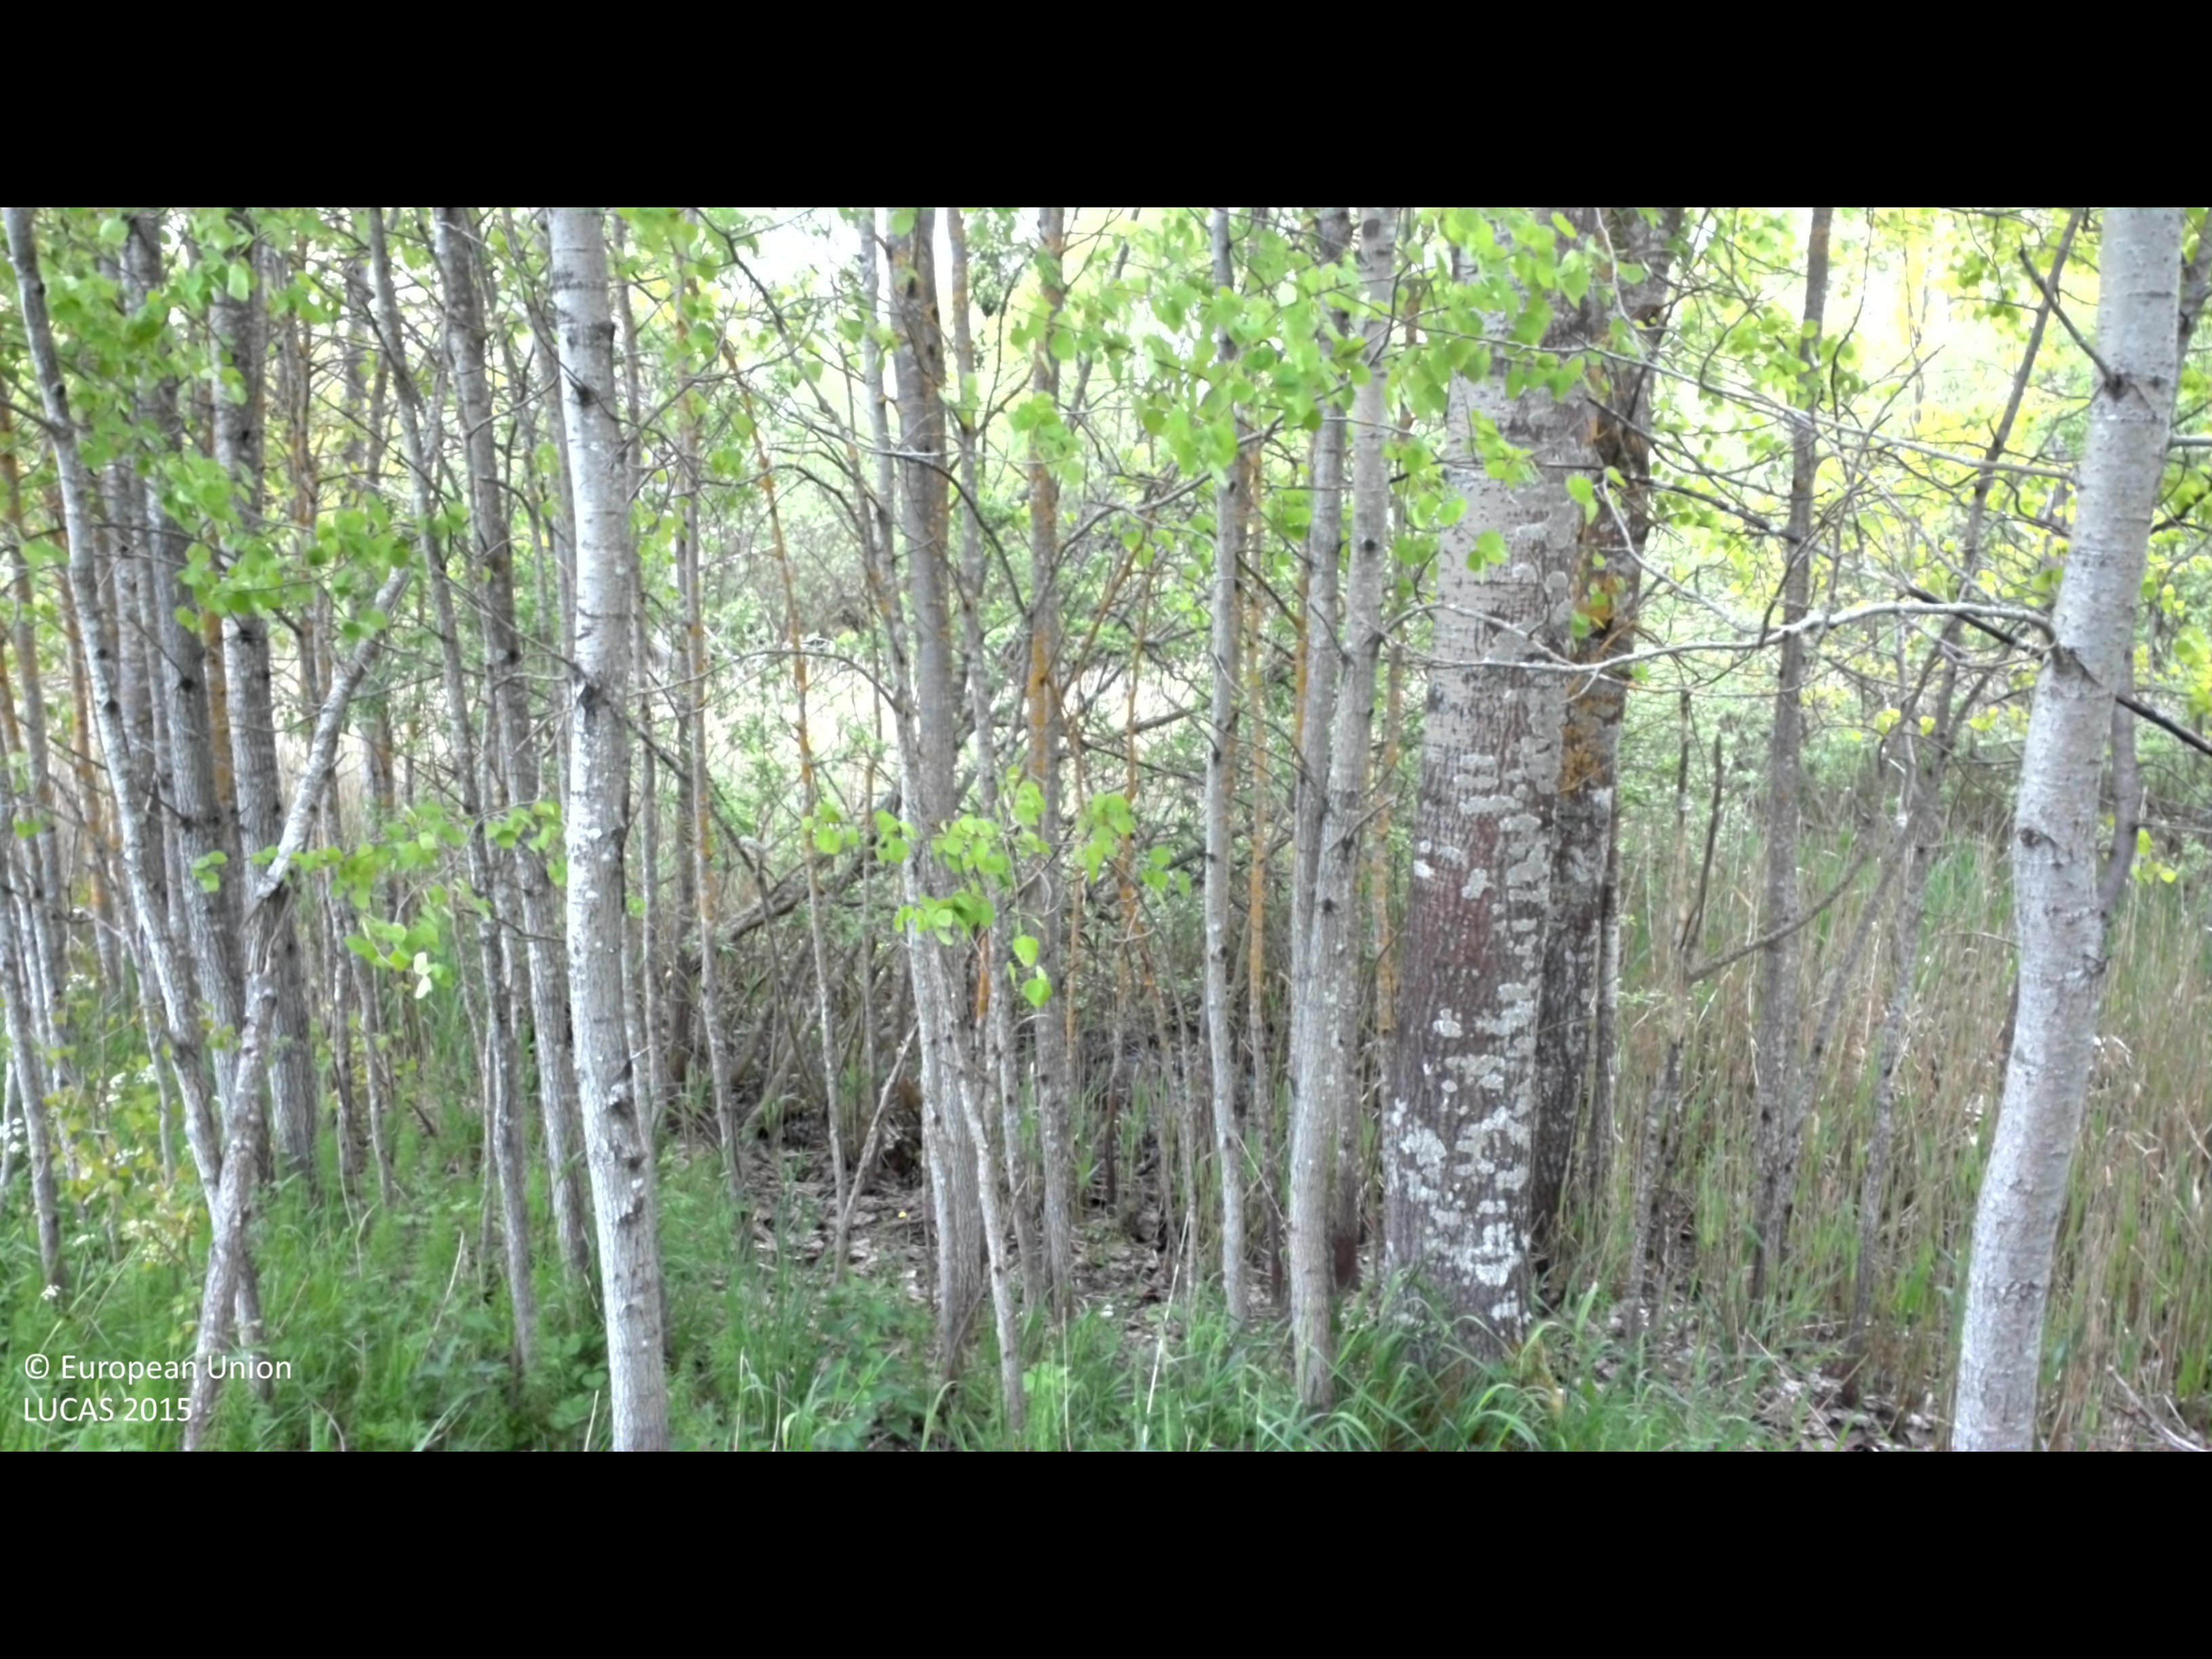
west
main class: Woodland
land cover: Broadleaved woodland
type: hemiboreal forest and nemoral coniferous forest and mixed broadleaved-coniferous forest
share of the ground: 50 - 75 %
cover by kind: broadleaved forest trees 50 %, herbaceous plants 25 %, shrubs 15 %, coniferous forest trees 5 %
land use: Forestry
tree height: > 5 m
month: June
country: SE
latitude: 57.6801
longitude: 16.1859
